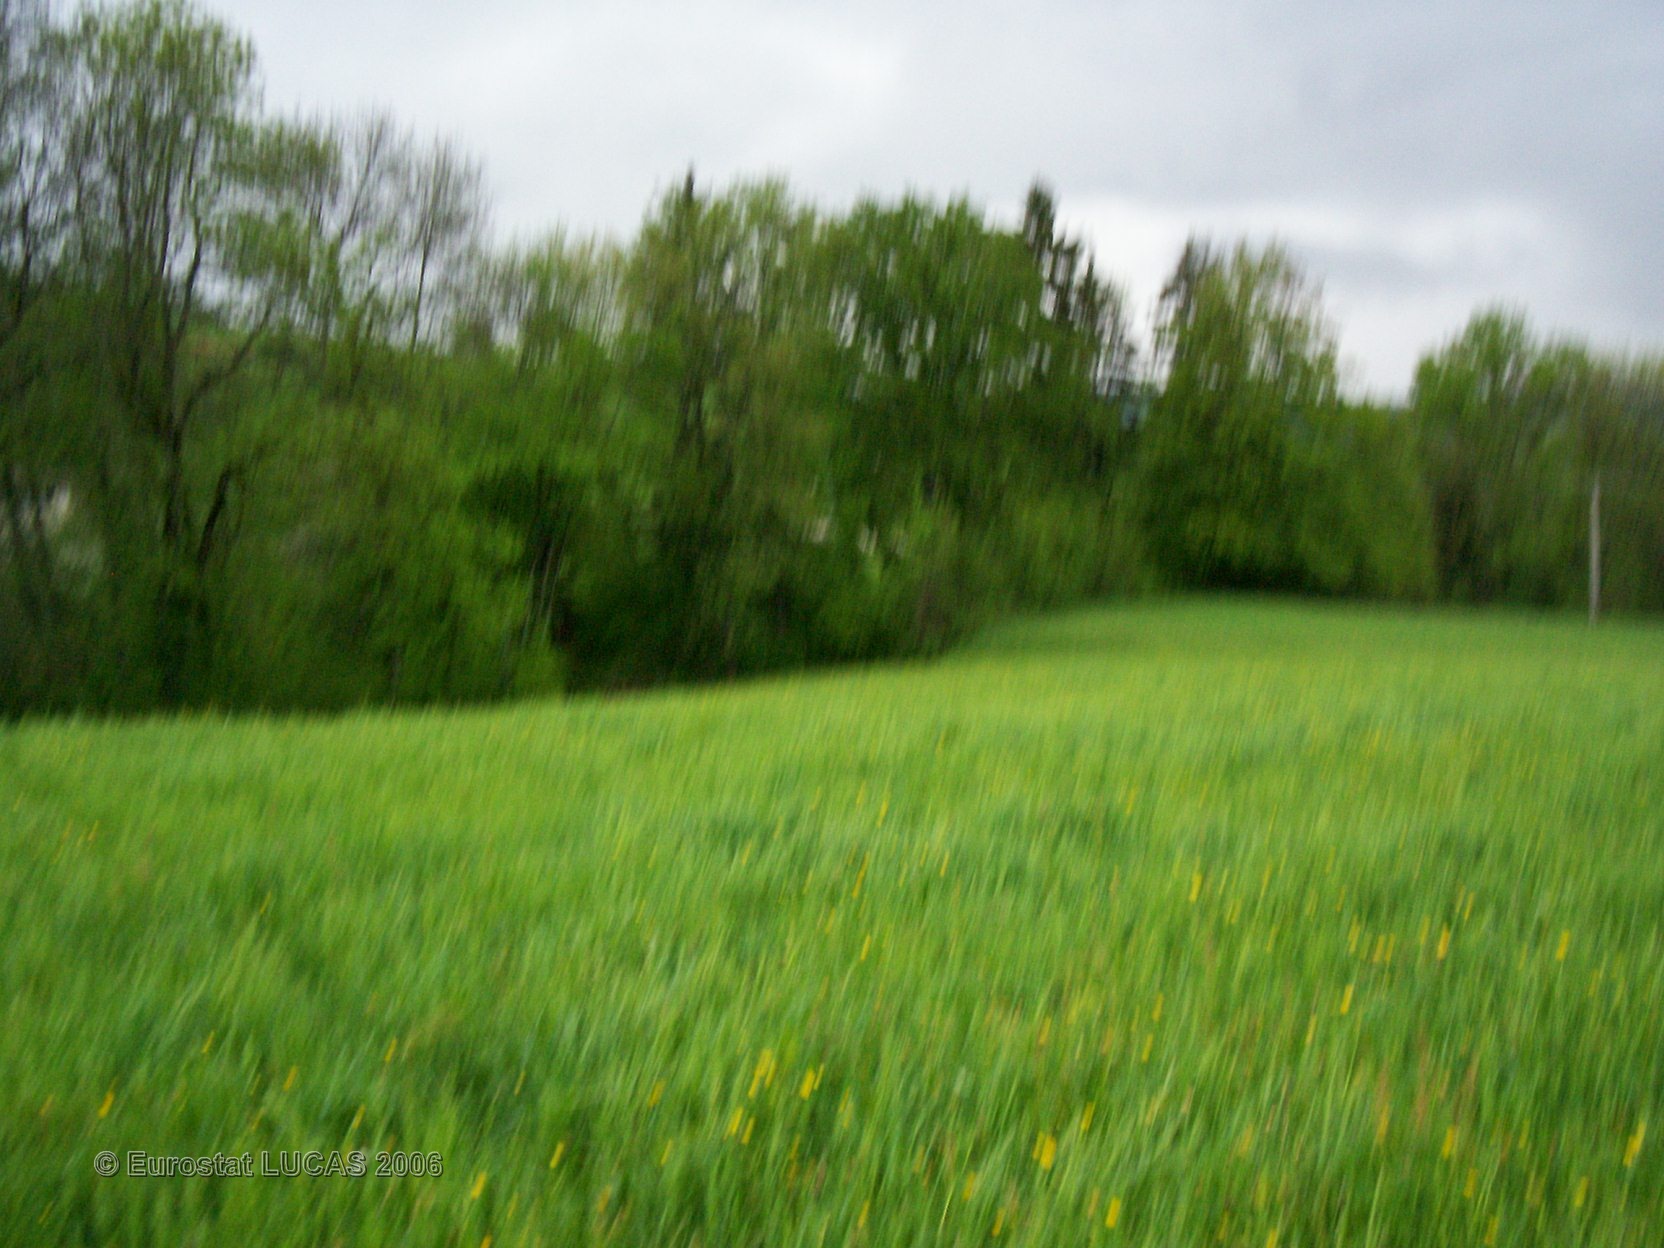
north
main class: Grassland
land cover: Grassland without tree/shrub cover
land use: Agriculture (excluding fallow land and kitchen gardens)
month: May
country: FR
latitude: 45.9922
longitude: 6.1177
